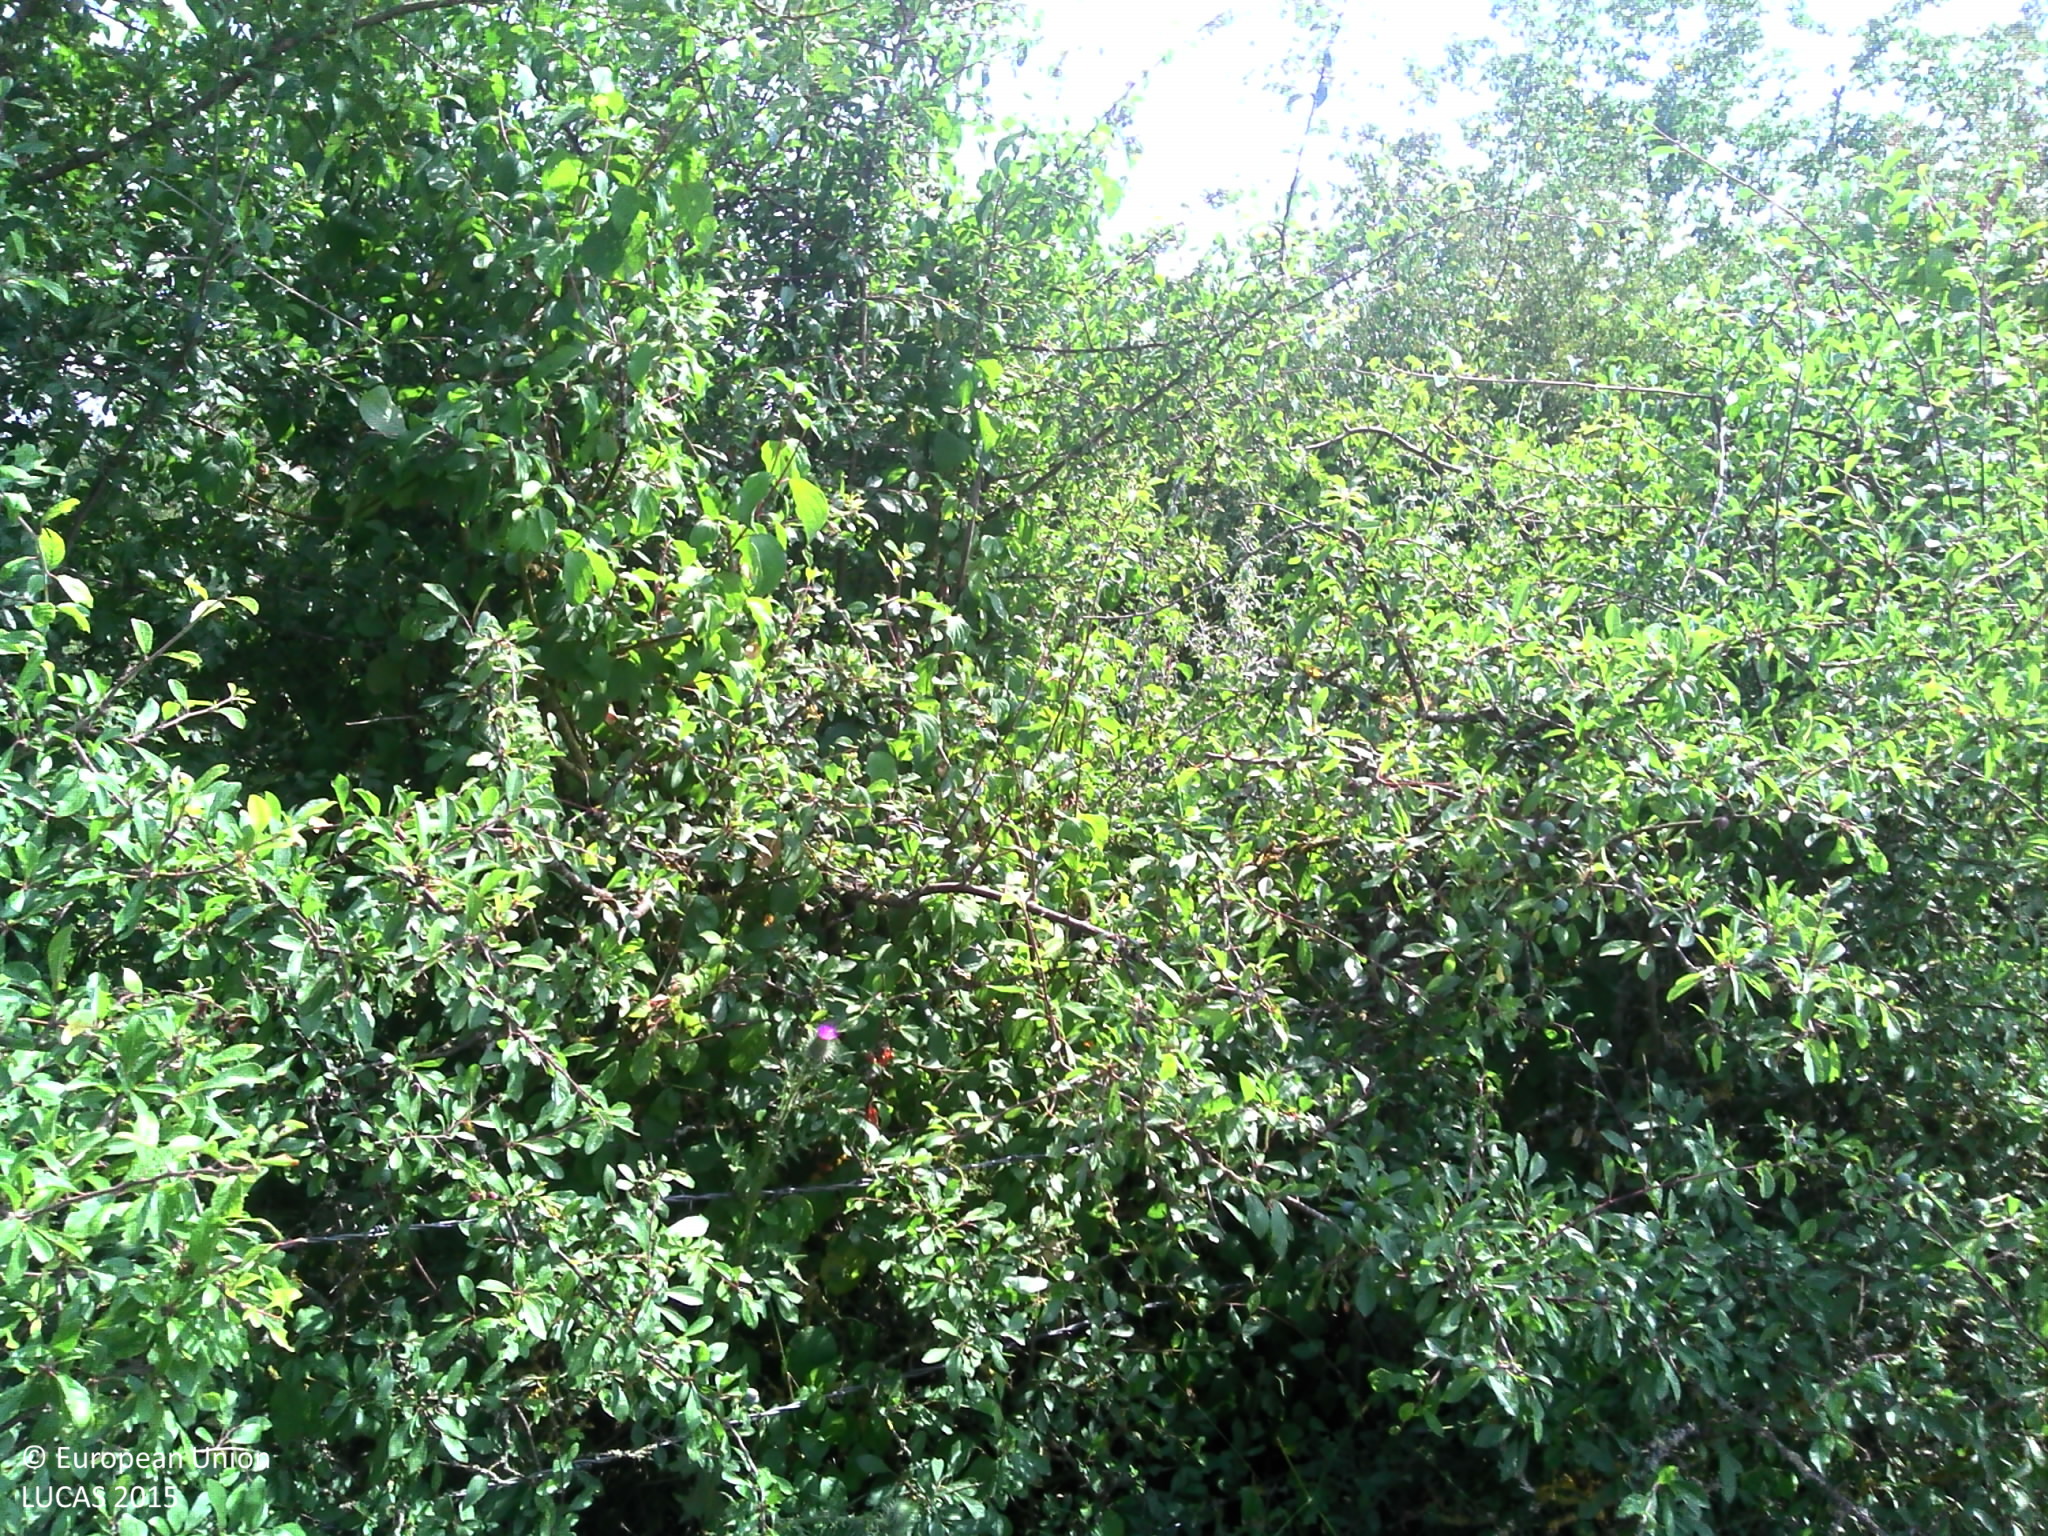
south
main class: Grassland
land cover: Grassland without tree/shrub cover
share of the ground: > 75 %
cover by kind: herbaceous plants 100 %
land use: Agriculture (excluding fallow land and kitchen gardens)
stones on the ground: < 10 %
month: July
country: FR
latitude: 48.1443
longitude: 4.9588
